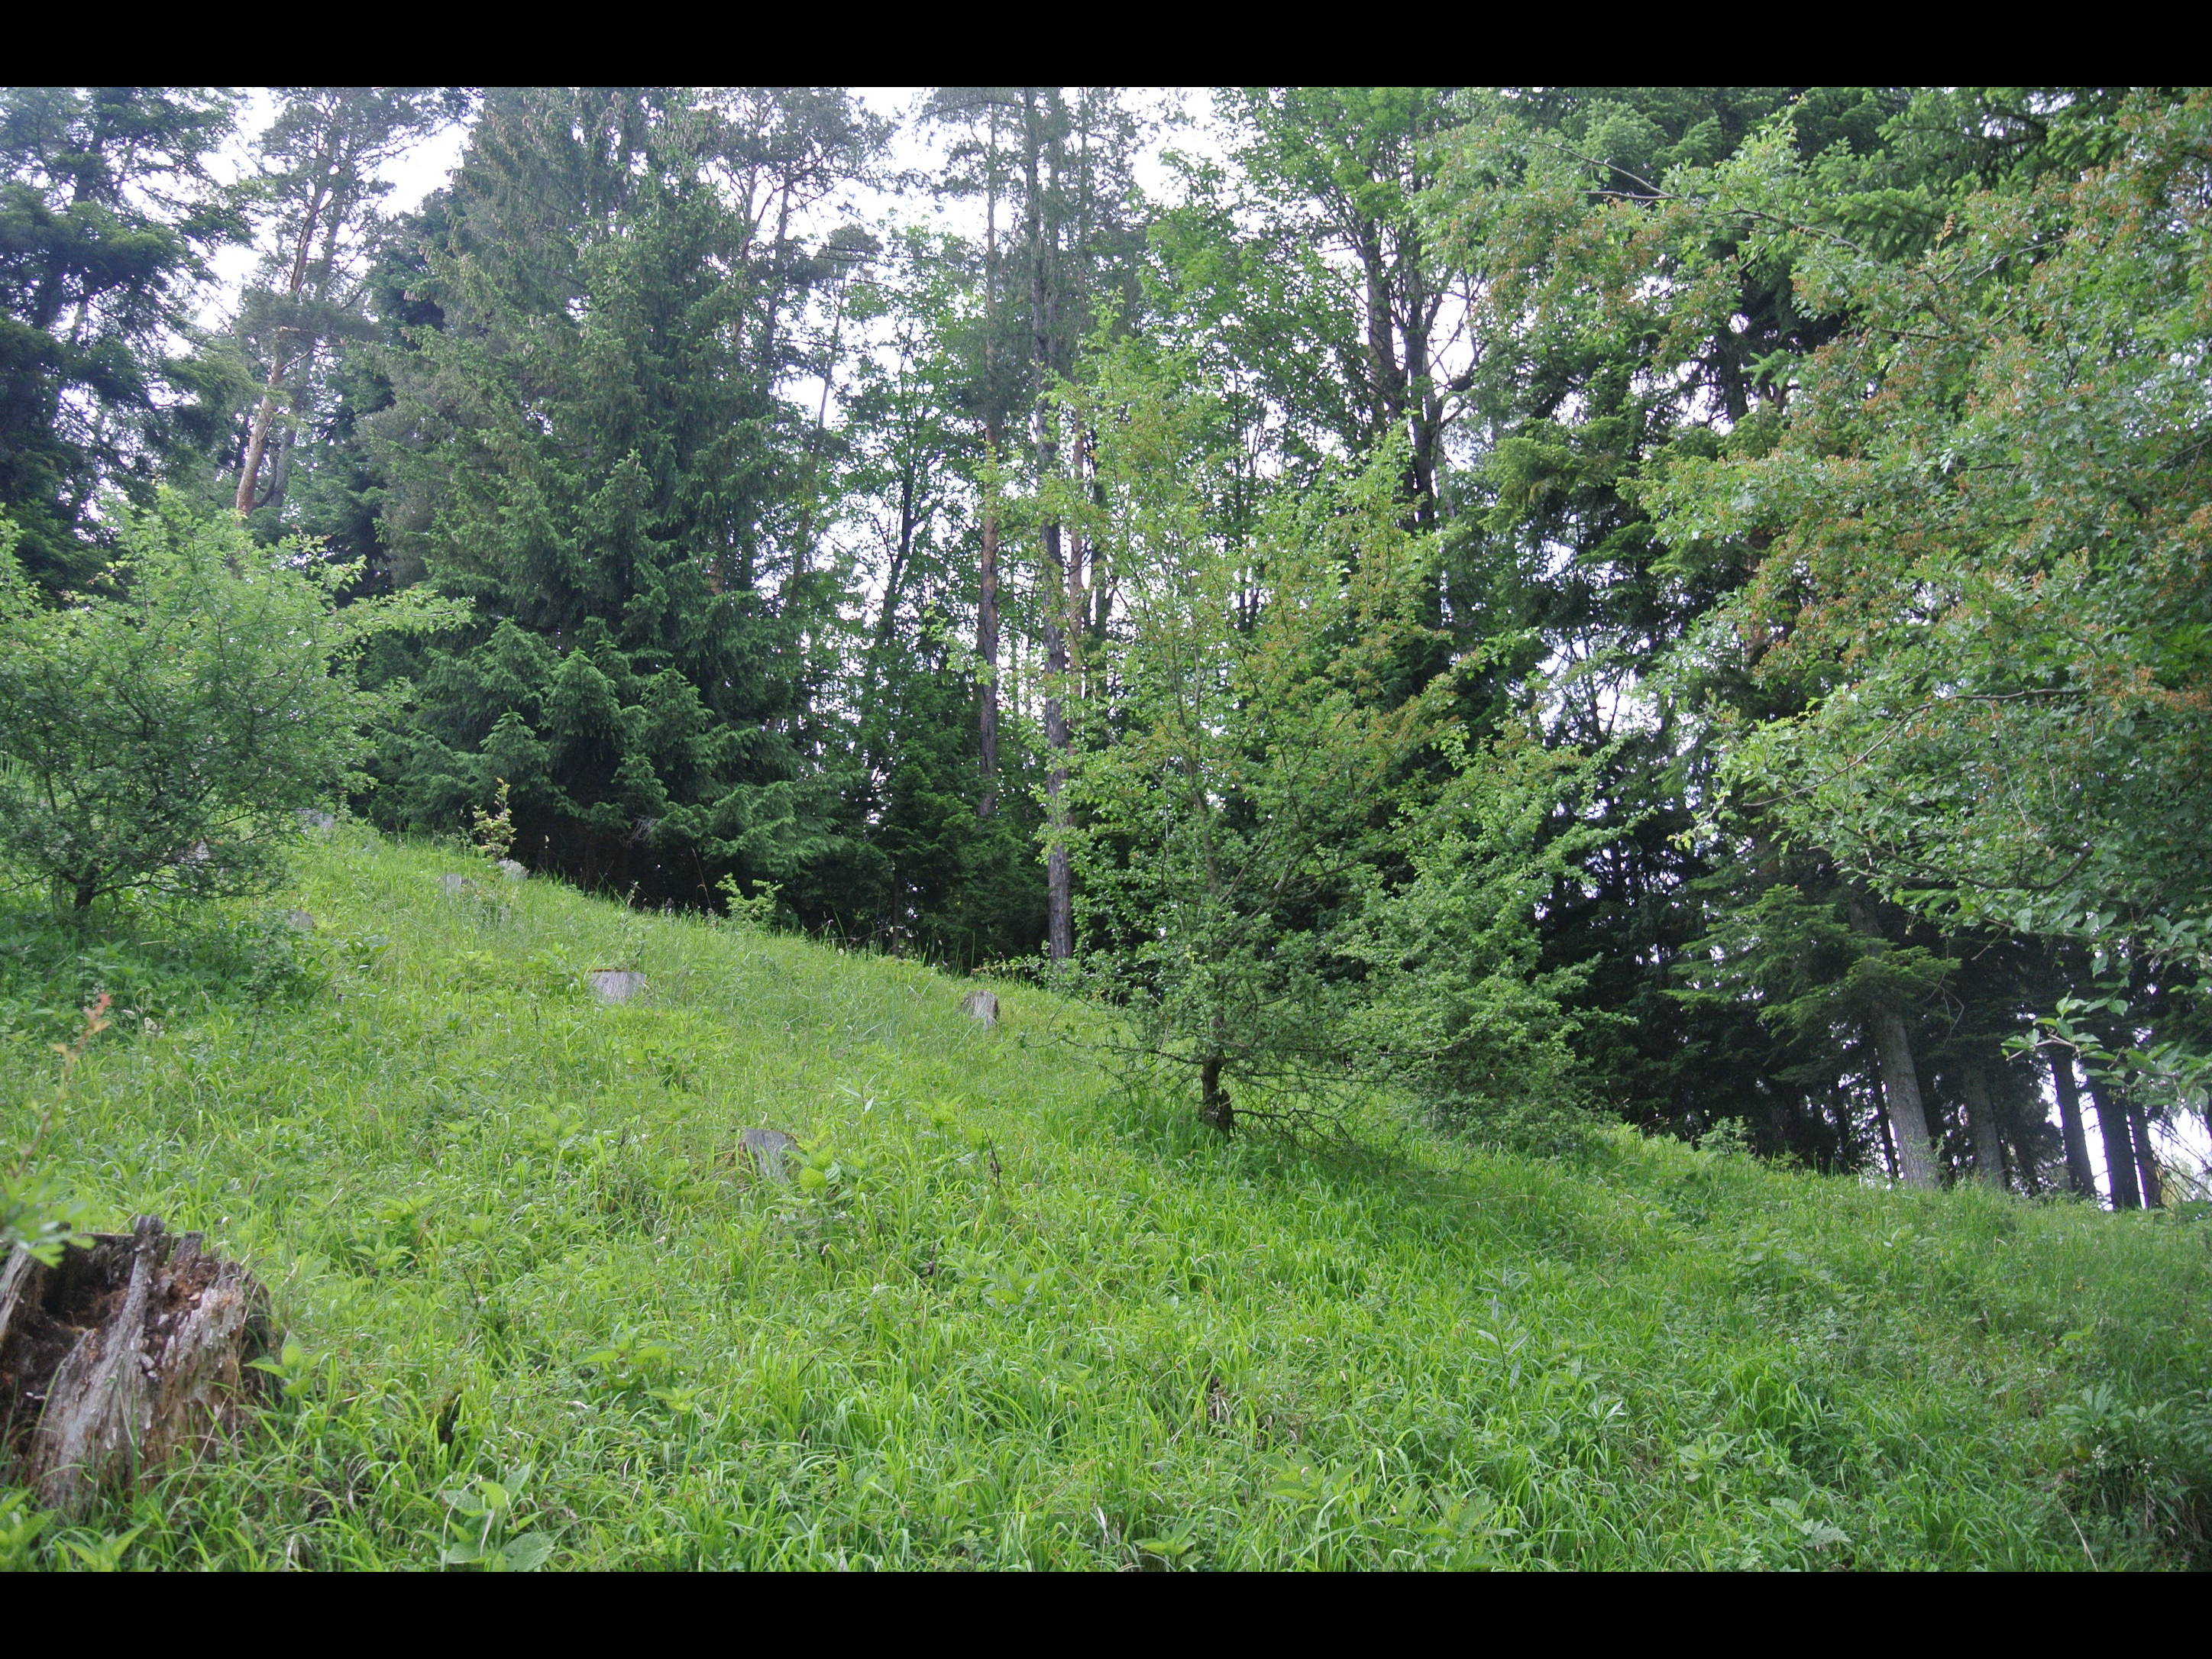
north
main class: Shrubland
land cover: Shrubland with sparse tree cover
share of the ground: > 75 %
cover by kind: herbaceous plants 80 %, shrubs 15 %, coniferous forest trees 5 %
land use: Forestry
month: June
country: AT
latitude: 47.8356
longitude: 15.8142
